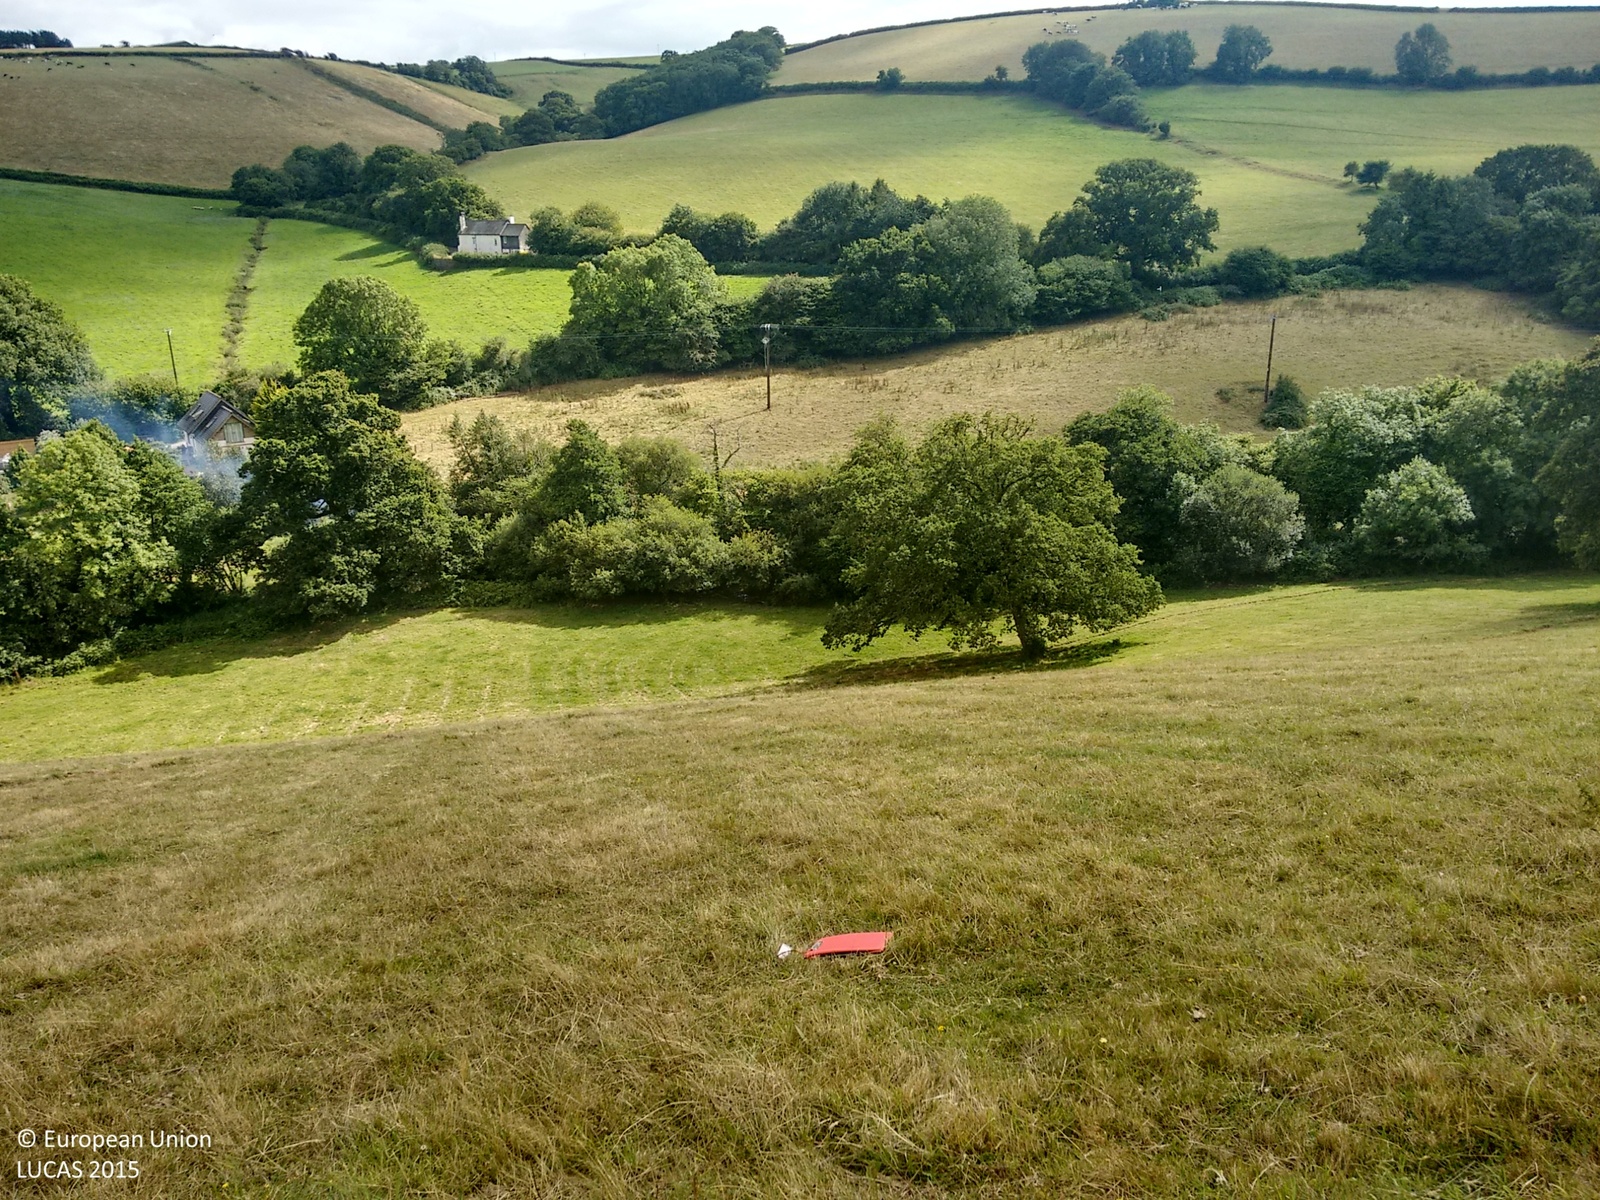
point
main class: Grassland
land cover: Grassland without tree/shrub cover
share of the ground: > 75 %
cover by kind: herbaceous plants 100 %
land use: Agriculture (excluding fallow land and kitchen gardens)
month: July
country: GB
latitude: 50.3825
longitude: -3.6290
